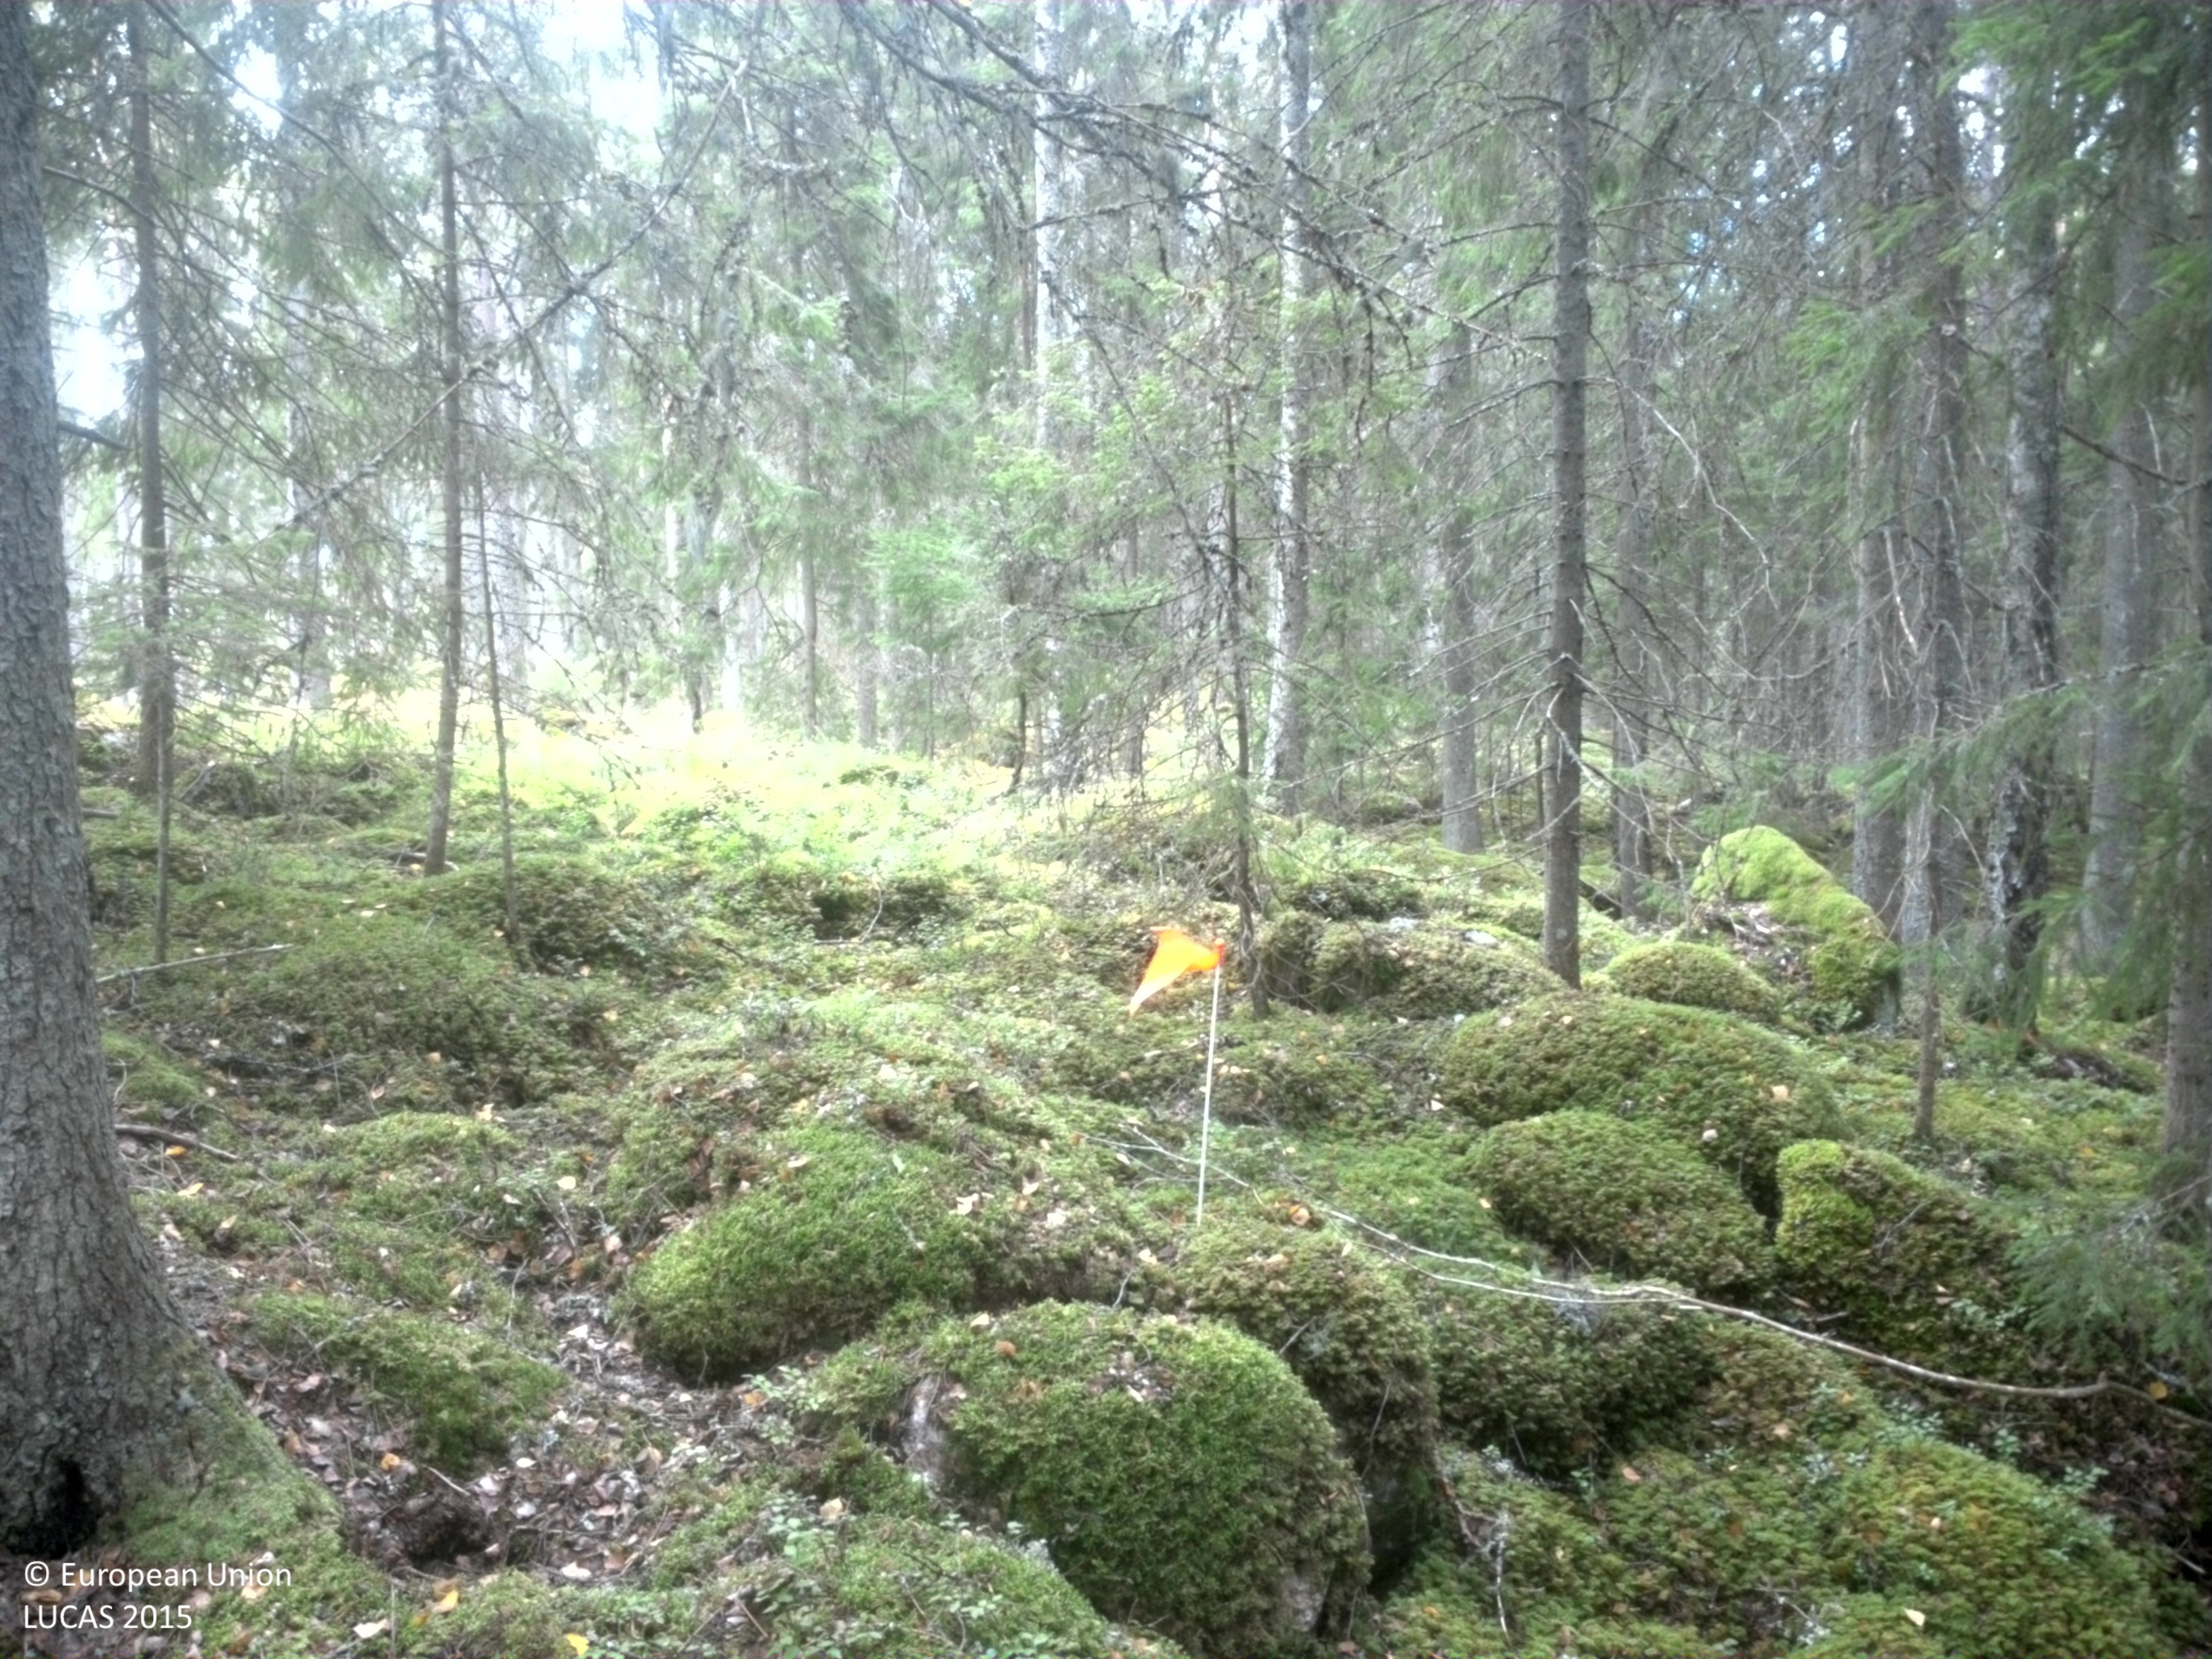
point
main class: Woodland
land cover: Spruce dominated coniferous woodland
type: boreal forest
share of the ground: > 75 %
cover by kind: coniferous forest trees 75 %, lichens and mosses 20 %, shrubs 5 %
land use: Forestry
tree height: > 5 m
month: September
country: SE
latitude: 59.5211
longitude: 15.7711
